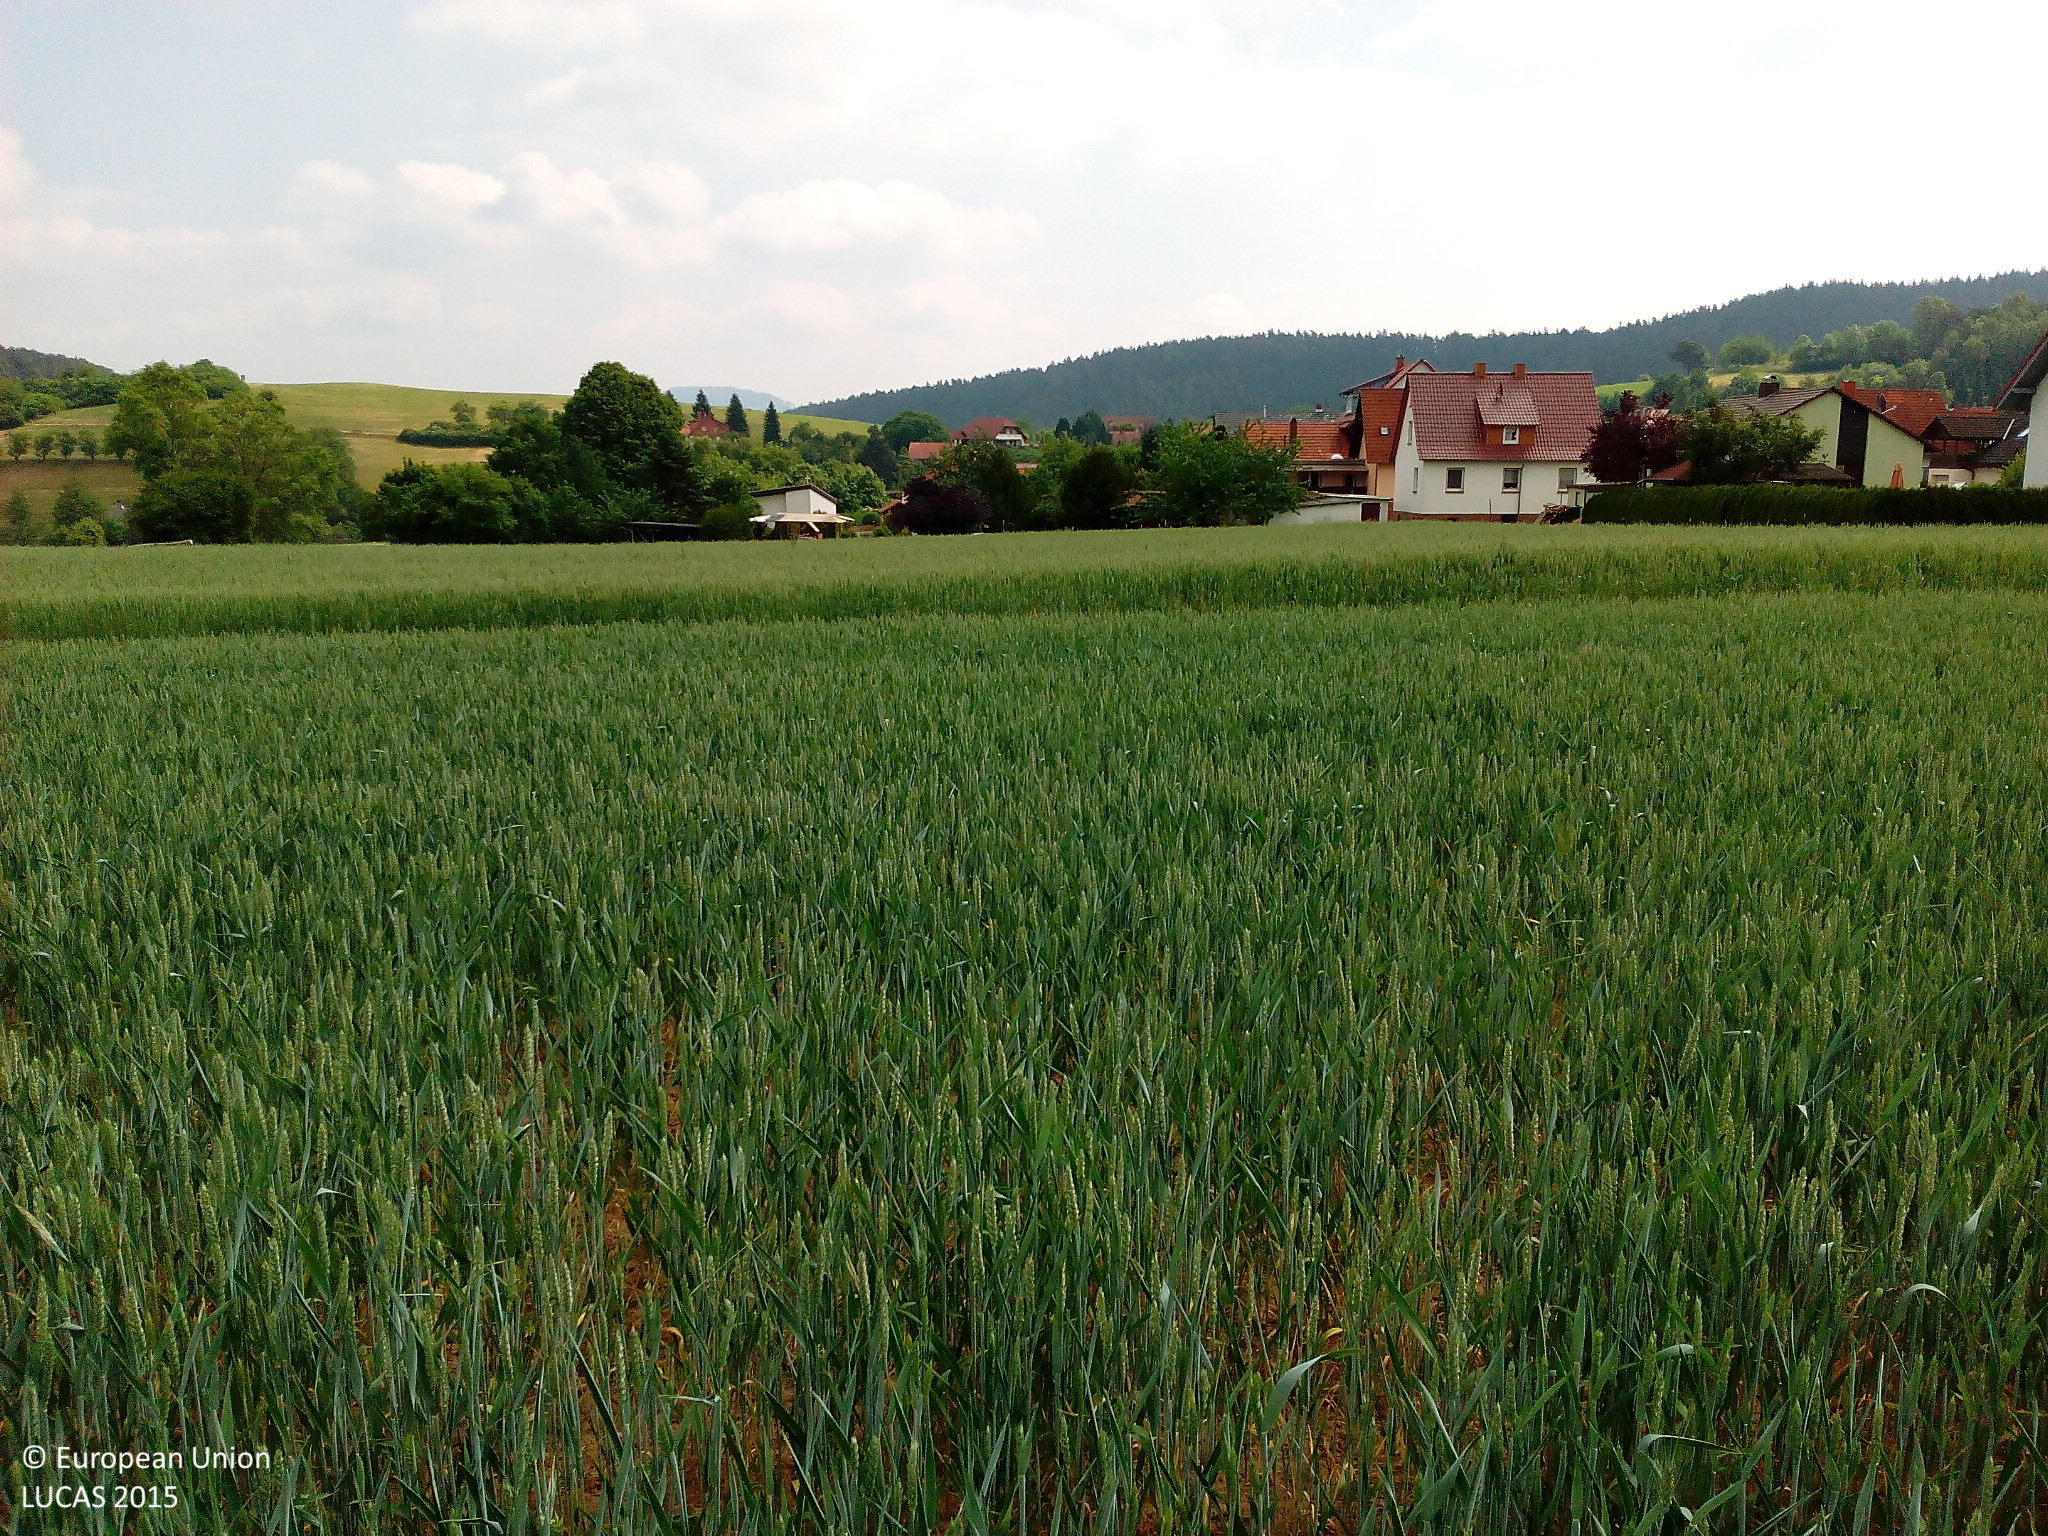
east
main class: Cropland
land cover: Common wheat
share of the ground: > 75 %
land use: Agriculture (excluding fallow land and kitchen gardens)
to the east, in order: Common wheat; Mixed cereals for fodder; Artificial constructions in urban areas
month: June
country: DE
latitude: 51.0108
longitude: 9.6438
